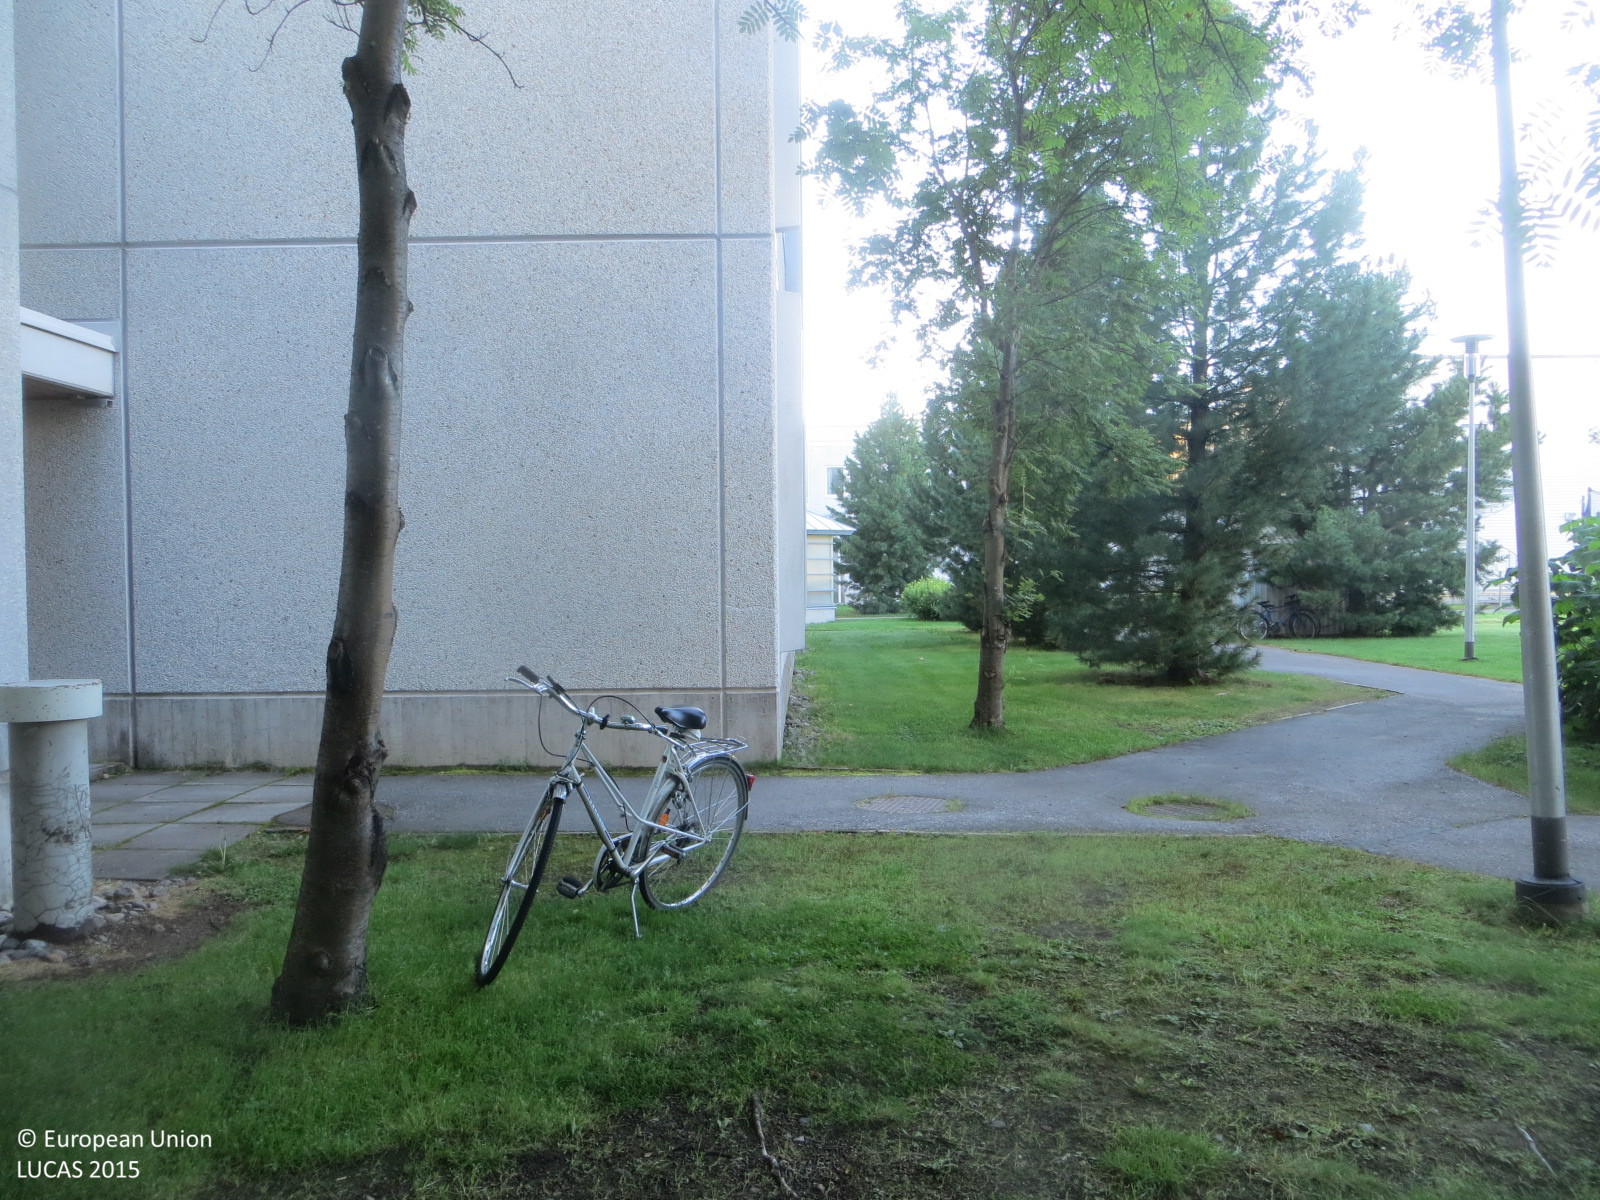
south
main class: Woodland
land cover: Broadleaved woodland
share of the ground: > 75 %
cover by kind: broadleaved forest trees 90 %, herbaceous plants 10 %
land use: Community services
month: August
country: FI
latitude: 66.4921
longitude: 25.7743
